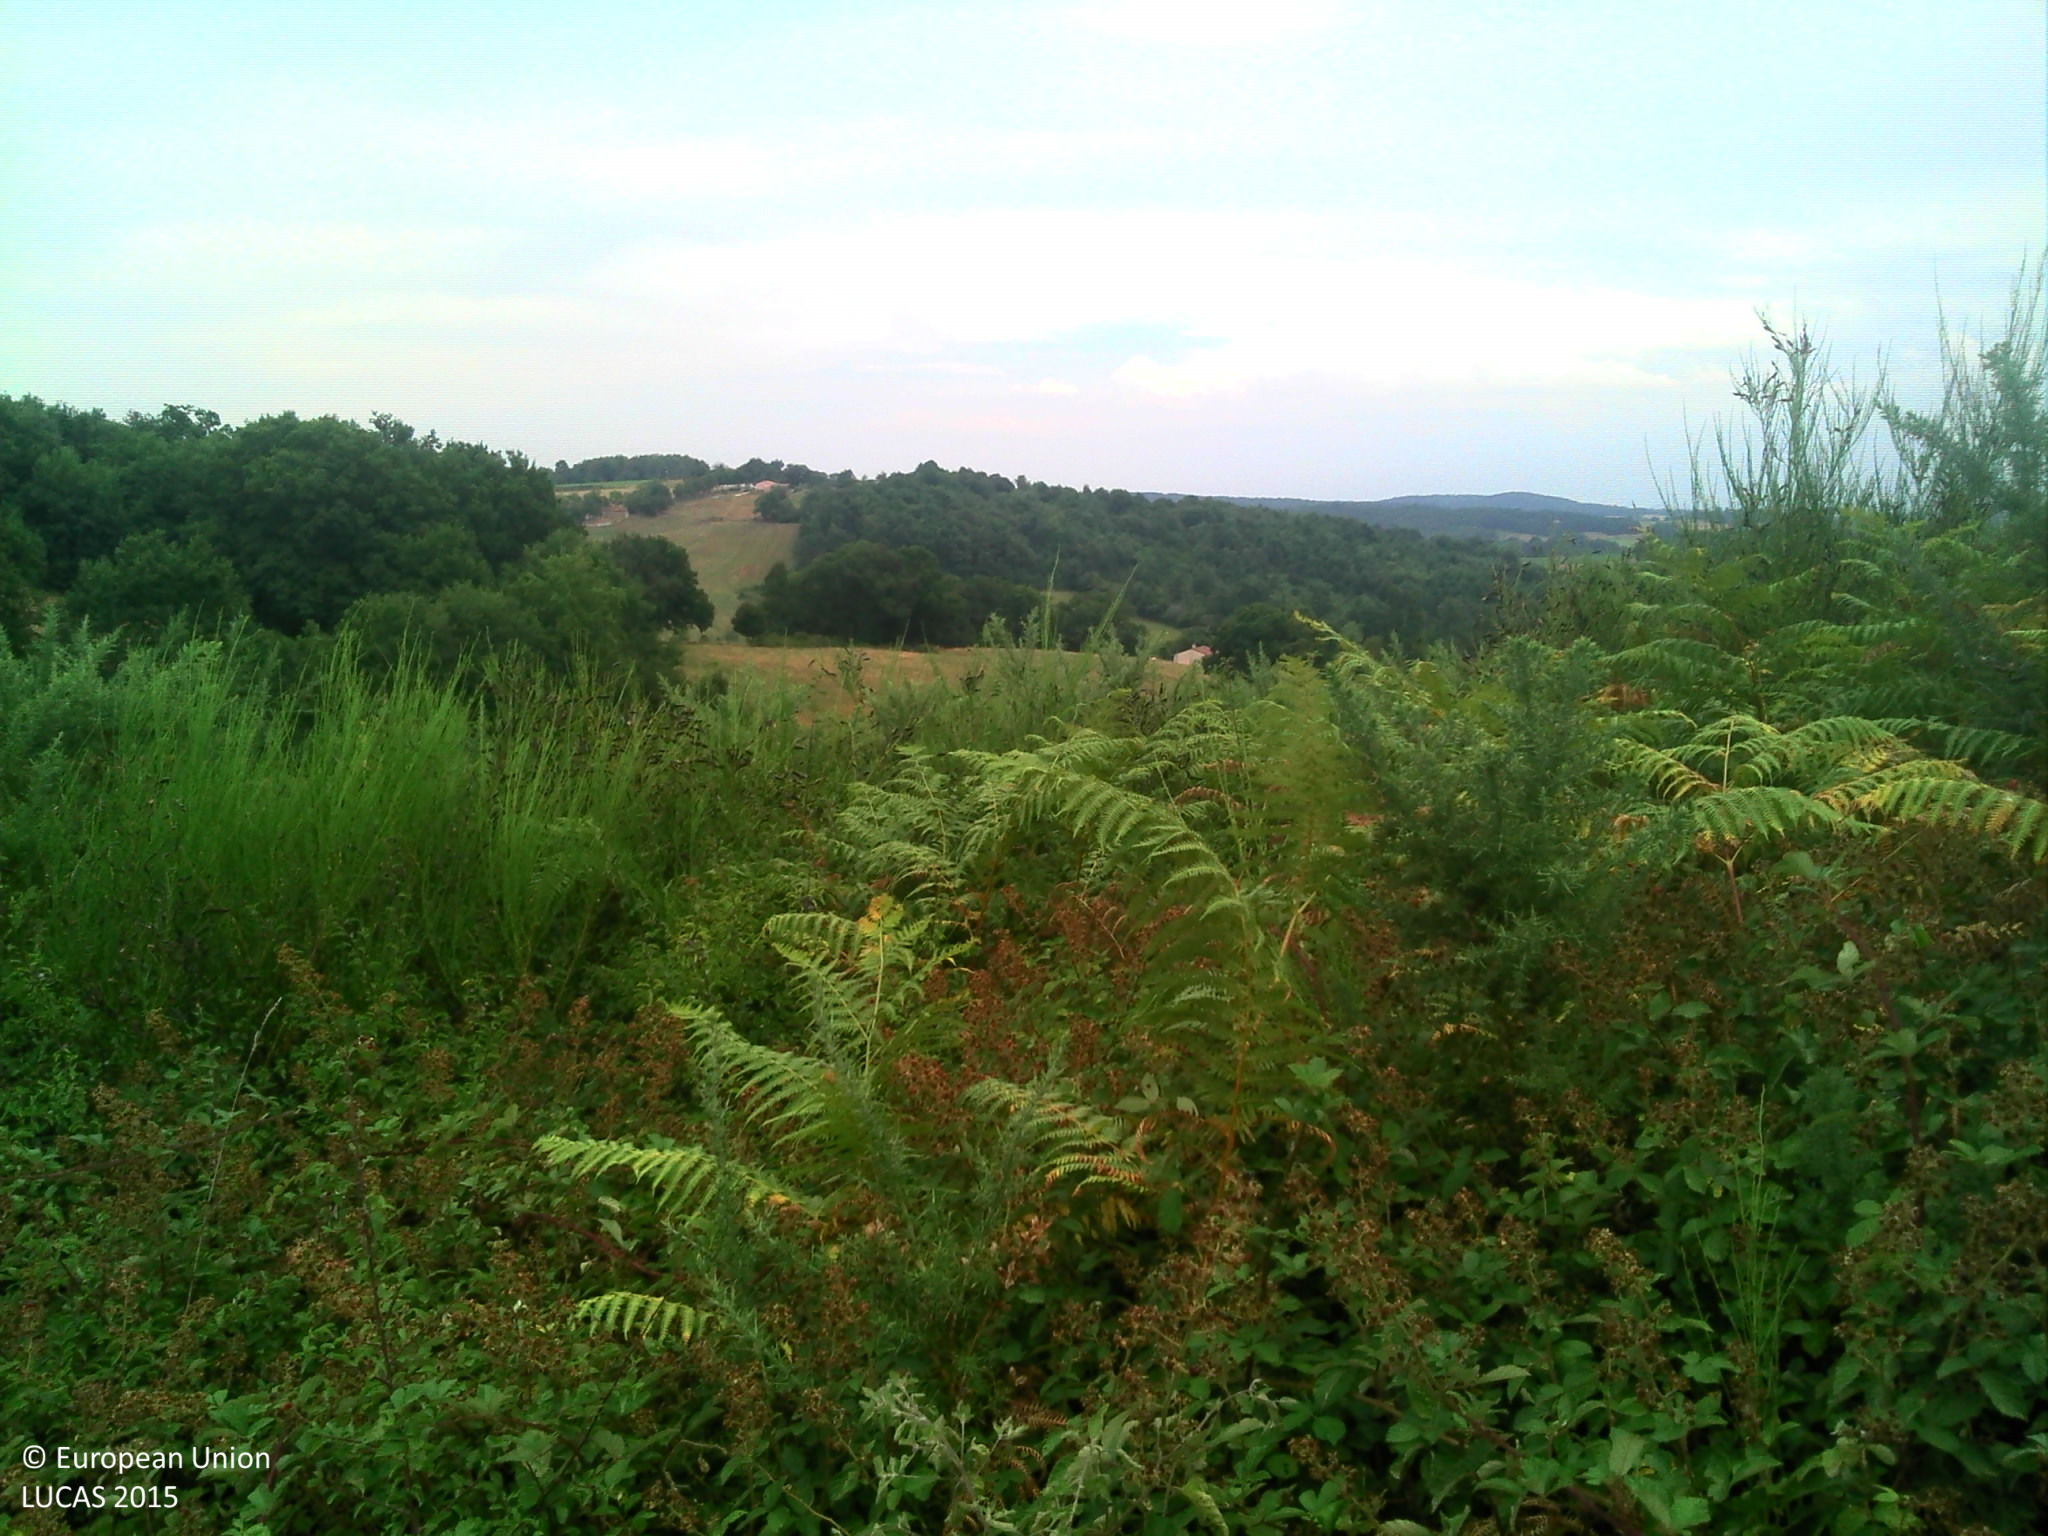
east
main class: Shrubland
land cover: Shrubland without tree cover
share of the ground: > 75 %
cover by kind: shrubs 100 %
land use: Semi-natural and natural areas not in use
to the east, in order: Shrubland without tree cover; Grassland without tree/shrub cover; Abandoned hedges; Fences; Grassland without tree/shrub cover
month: July
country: FR
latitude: 43.1755
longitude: 0.7630
